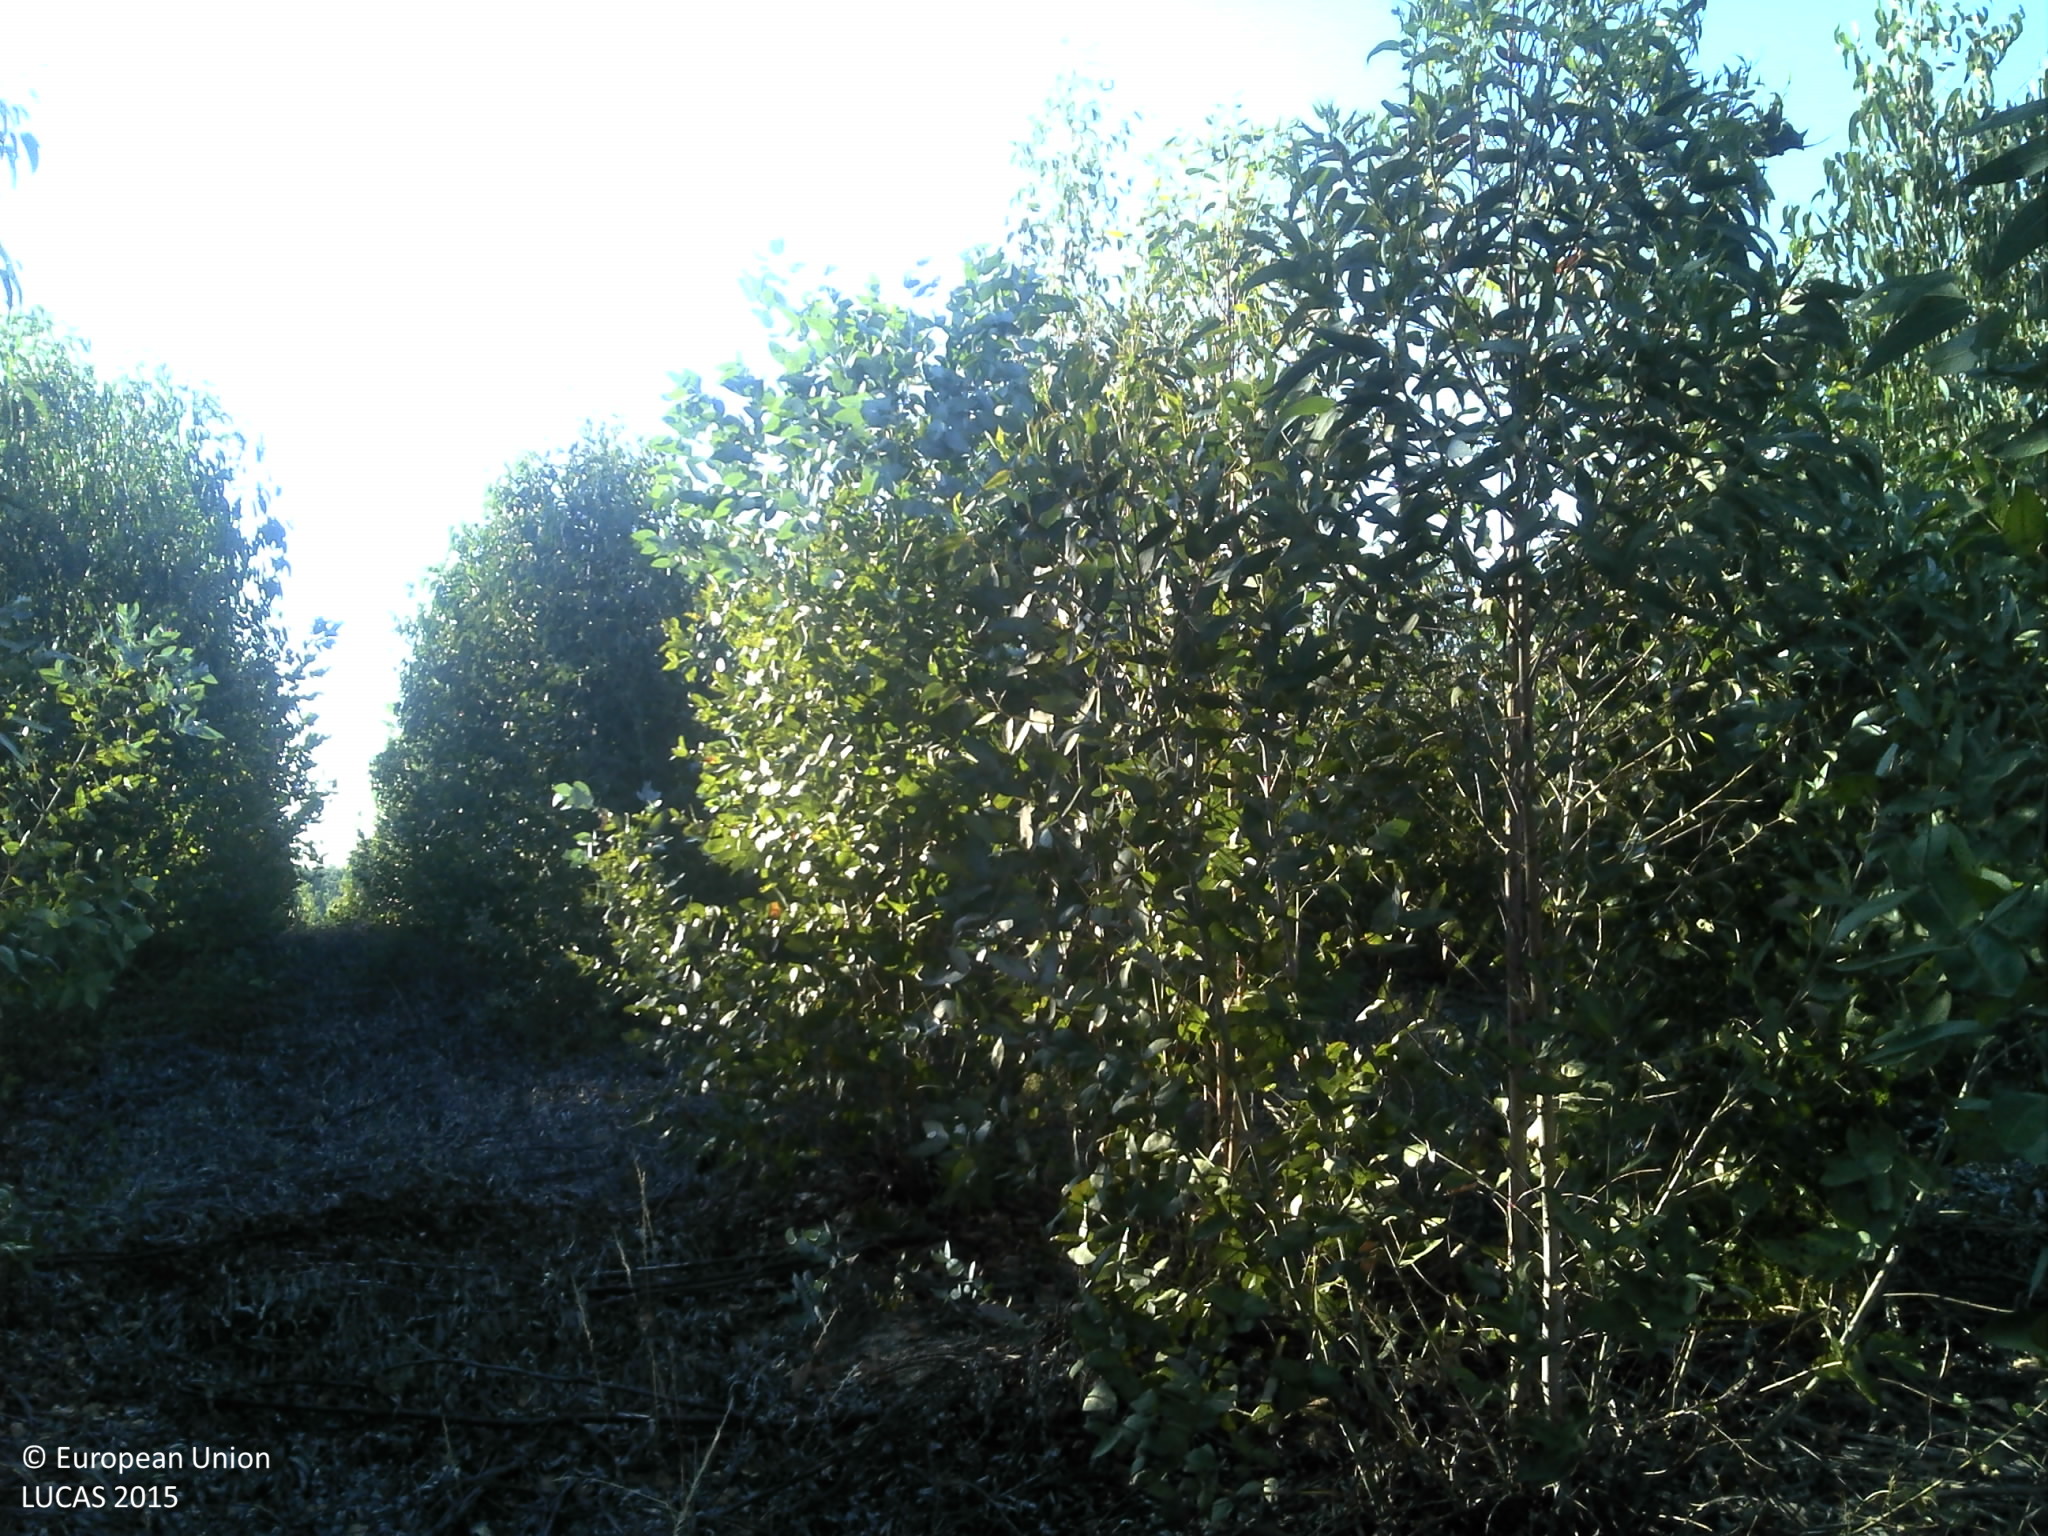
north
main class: Woodland
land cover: Broadleaved woodland
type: exotic forest
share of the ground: 50 - 75 %
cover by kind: broadleaved forest trees 70 %, unconsolidated bare surface 30 %
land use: Forestry
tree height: > 5 m
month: June
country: PT
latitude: 39.0776
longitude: -8.7155
